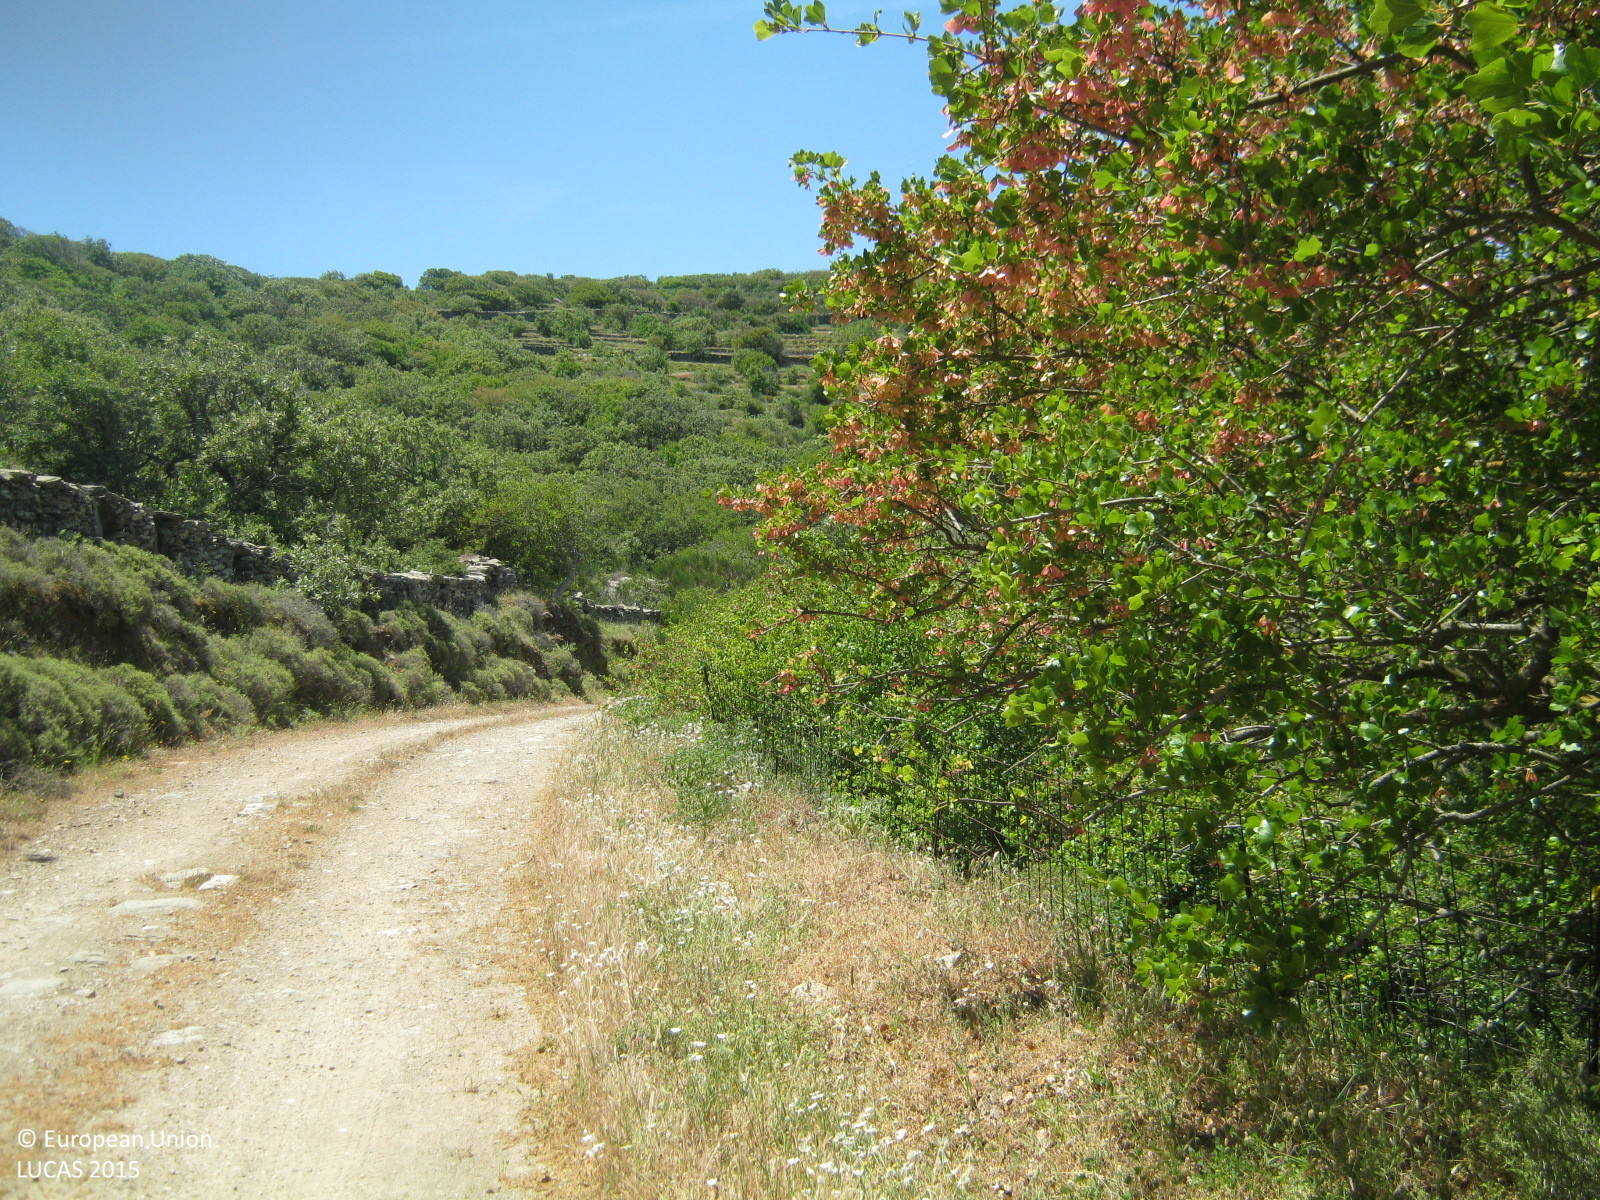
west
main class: Woodland
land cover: Broadleaved woodland
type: thermophilous deciduous forest
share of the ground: > 75 %
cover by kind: broadleaved forest trees 75 %, herbaceous plants 10 %, unconsolidated bare surface 10 %, shrubs 5 %
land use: Semi-natural and natural areas not in use
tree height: > 5 m
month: May
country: GR
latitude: 37.6079
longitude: 24.3568
